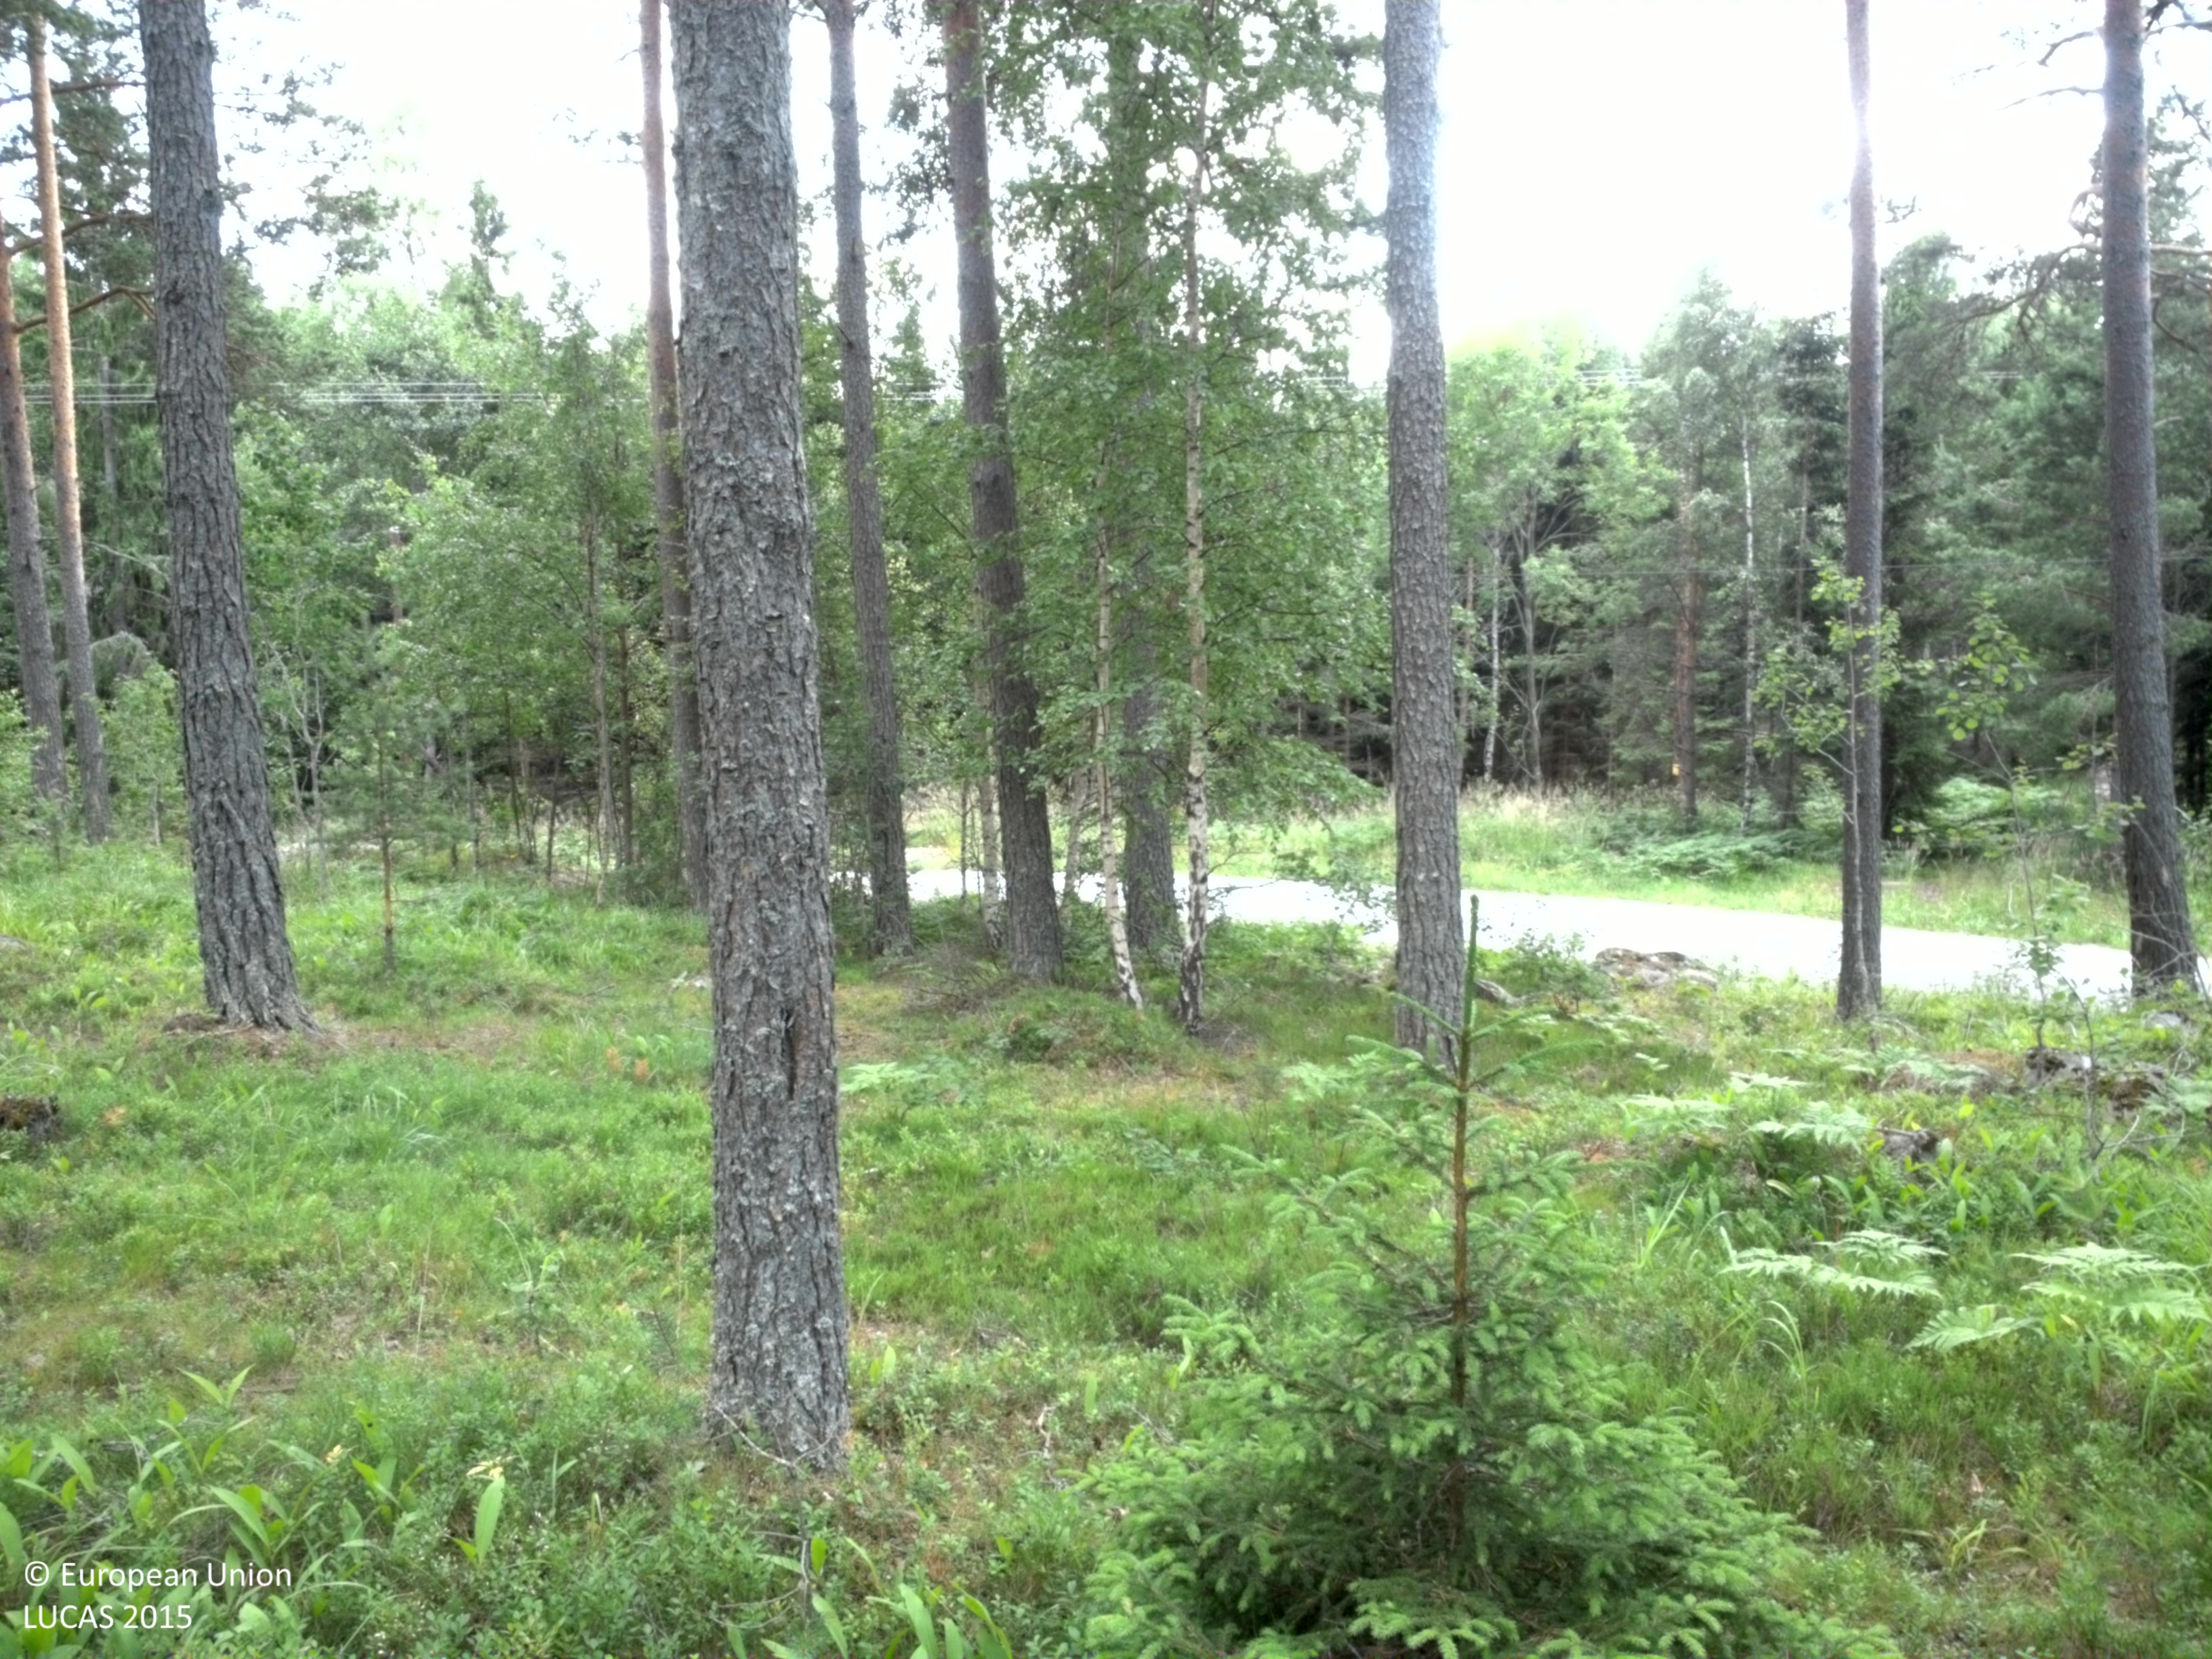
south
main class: Woodland
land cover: Pine dominated coniferous woodland
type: boreal forest
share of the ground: > 75 %
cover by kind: coniferous forest trees 70 %, herbaceous plants 20 %, broadleaved forest trees 10 %
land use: Forestry
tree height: > 5 m
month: July
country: SE
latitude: 59.5894
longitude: 18.3408
